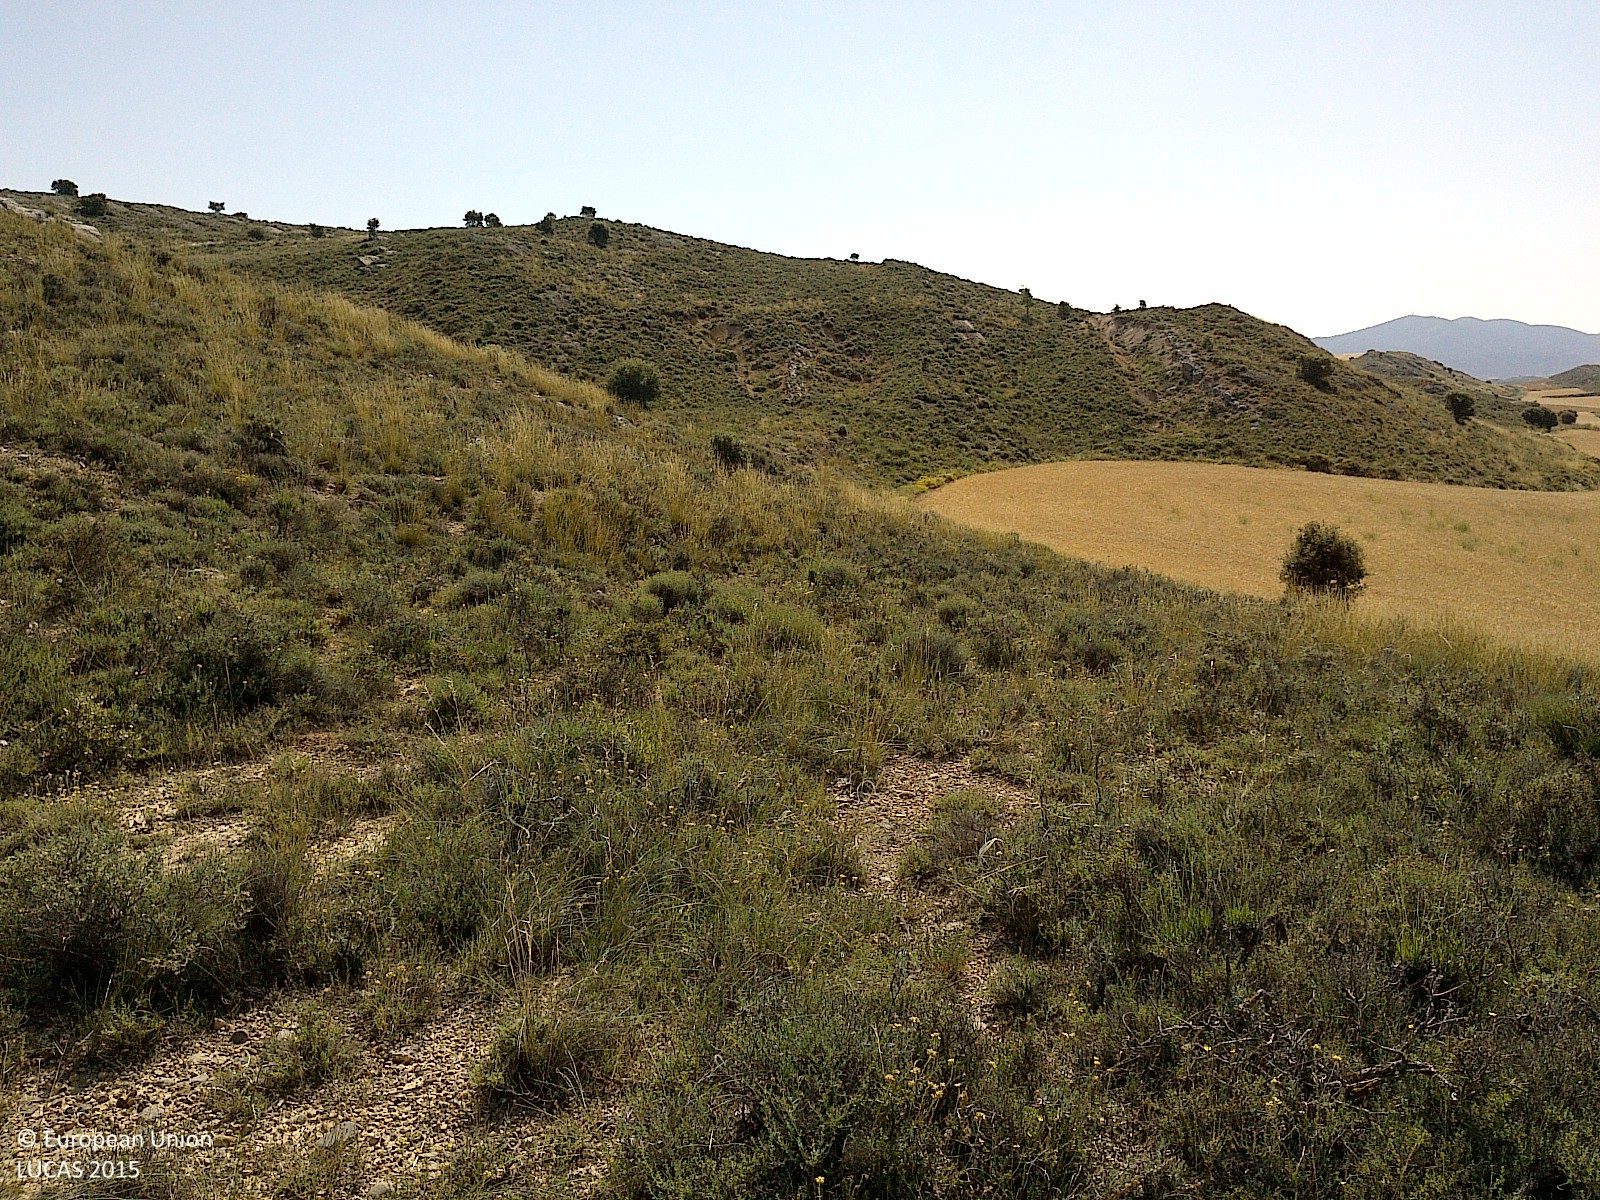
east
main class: Shrubland
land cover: Shrubland without tree cover
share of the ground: > 75 %
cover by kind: shrubs 75 %, unconsolidated bare surface 20 %, consolidated bare surface 5 %
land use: Semi-natural and natural areas not in use
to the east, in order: Shrubland without tree cover; Dry stone walls; Shrubland without tree cover
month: July
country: ES
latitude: 41.5365
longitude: -2.1502
